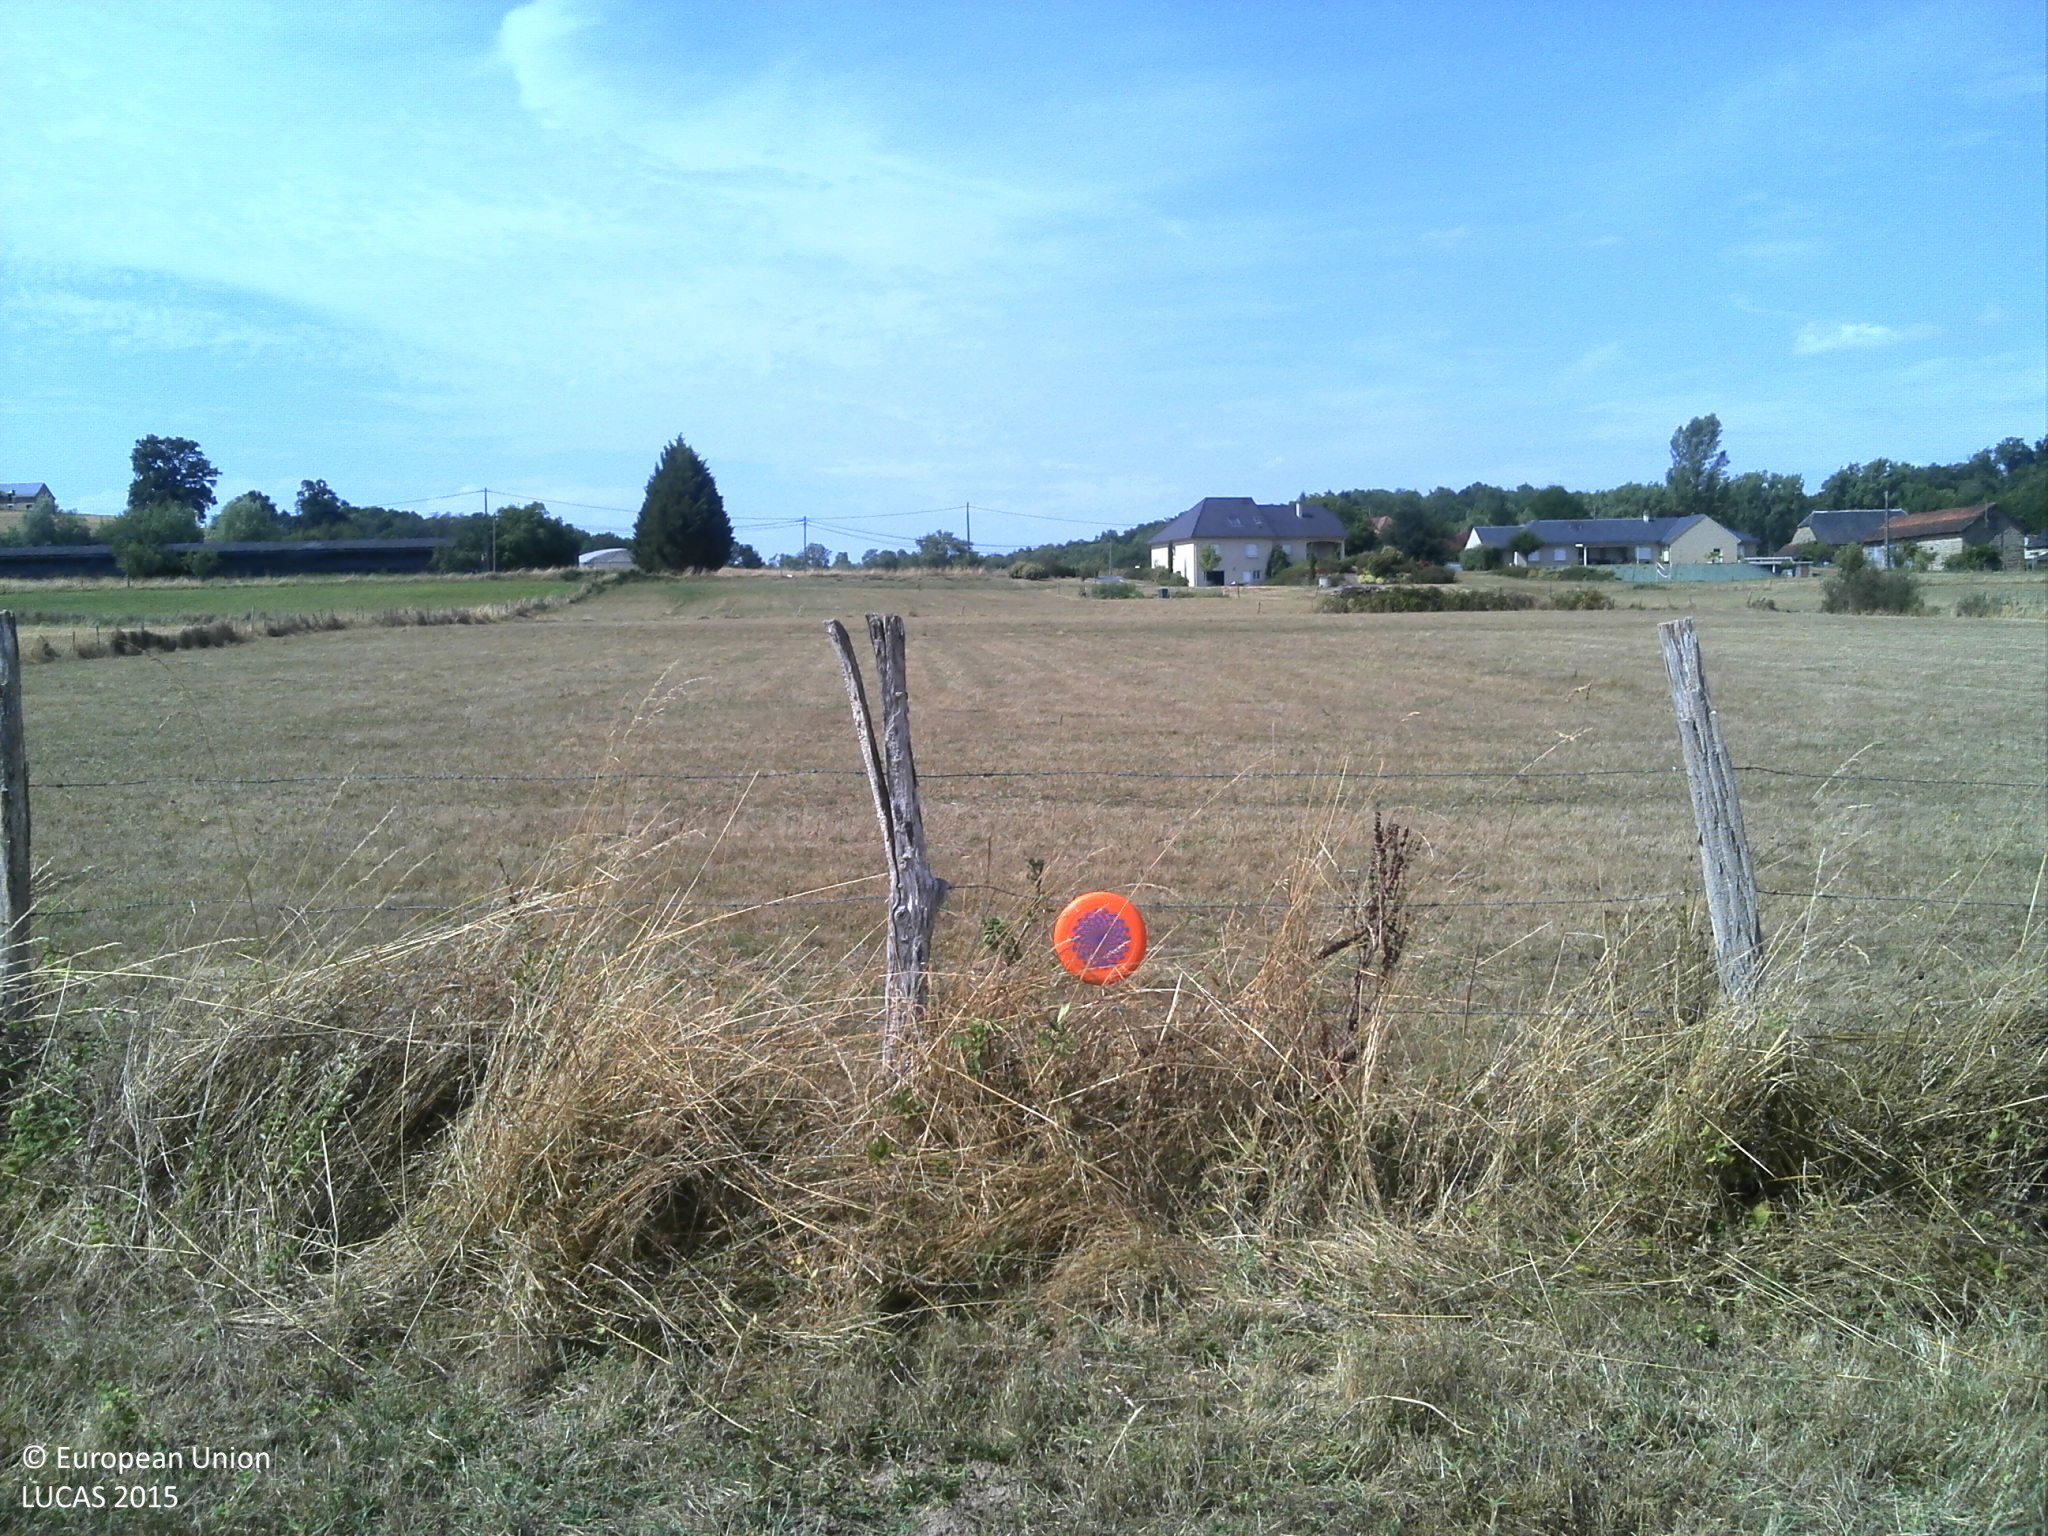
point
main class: Grassland
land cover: Grassland without tree/shrub cover
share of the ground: > 75 %
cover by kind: herbaceous plants 100 %
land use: Agriculture (excluding fallow land and kitchen gardens)
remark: Harvested field
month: July
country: FR
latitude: 45.1358
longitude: 1.4115
